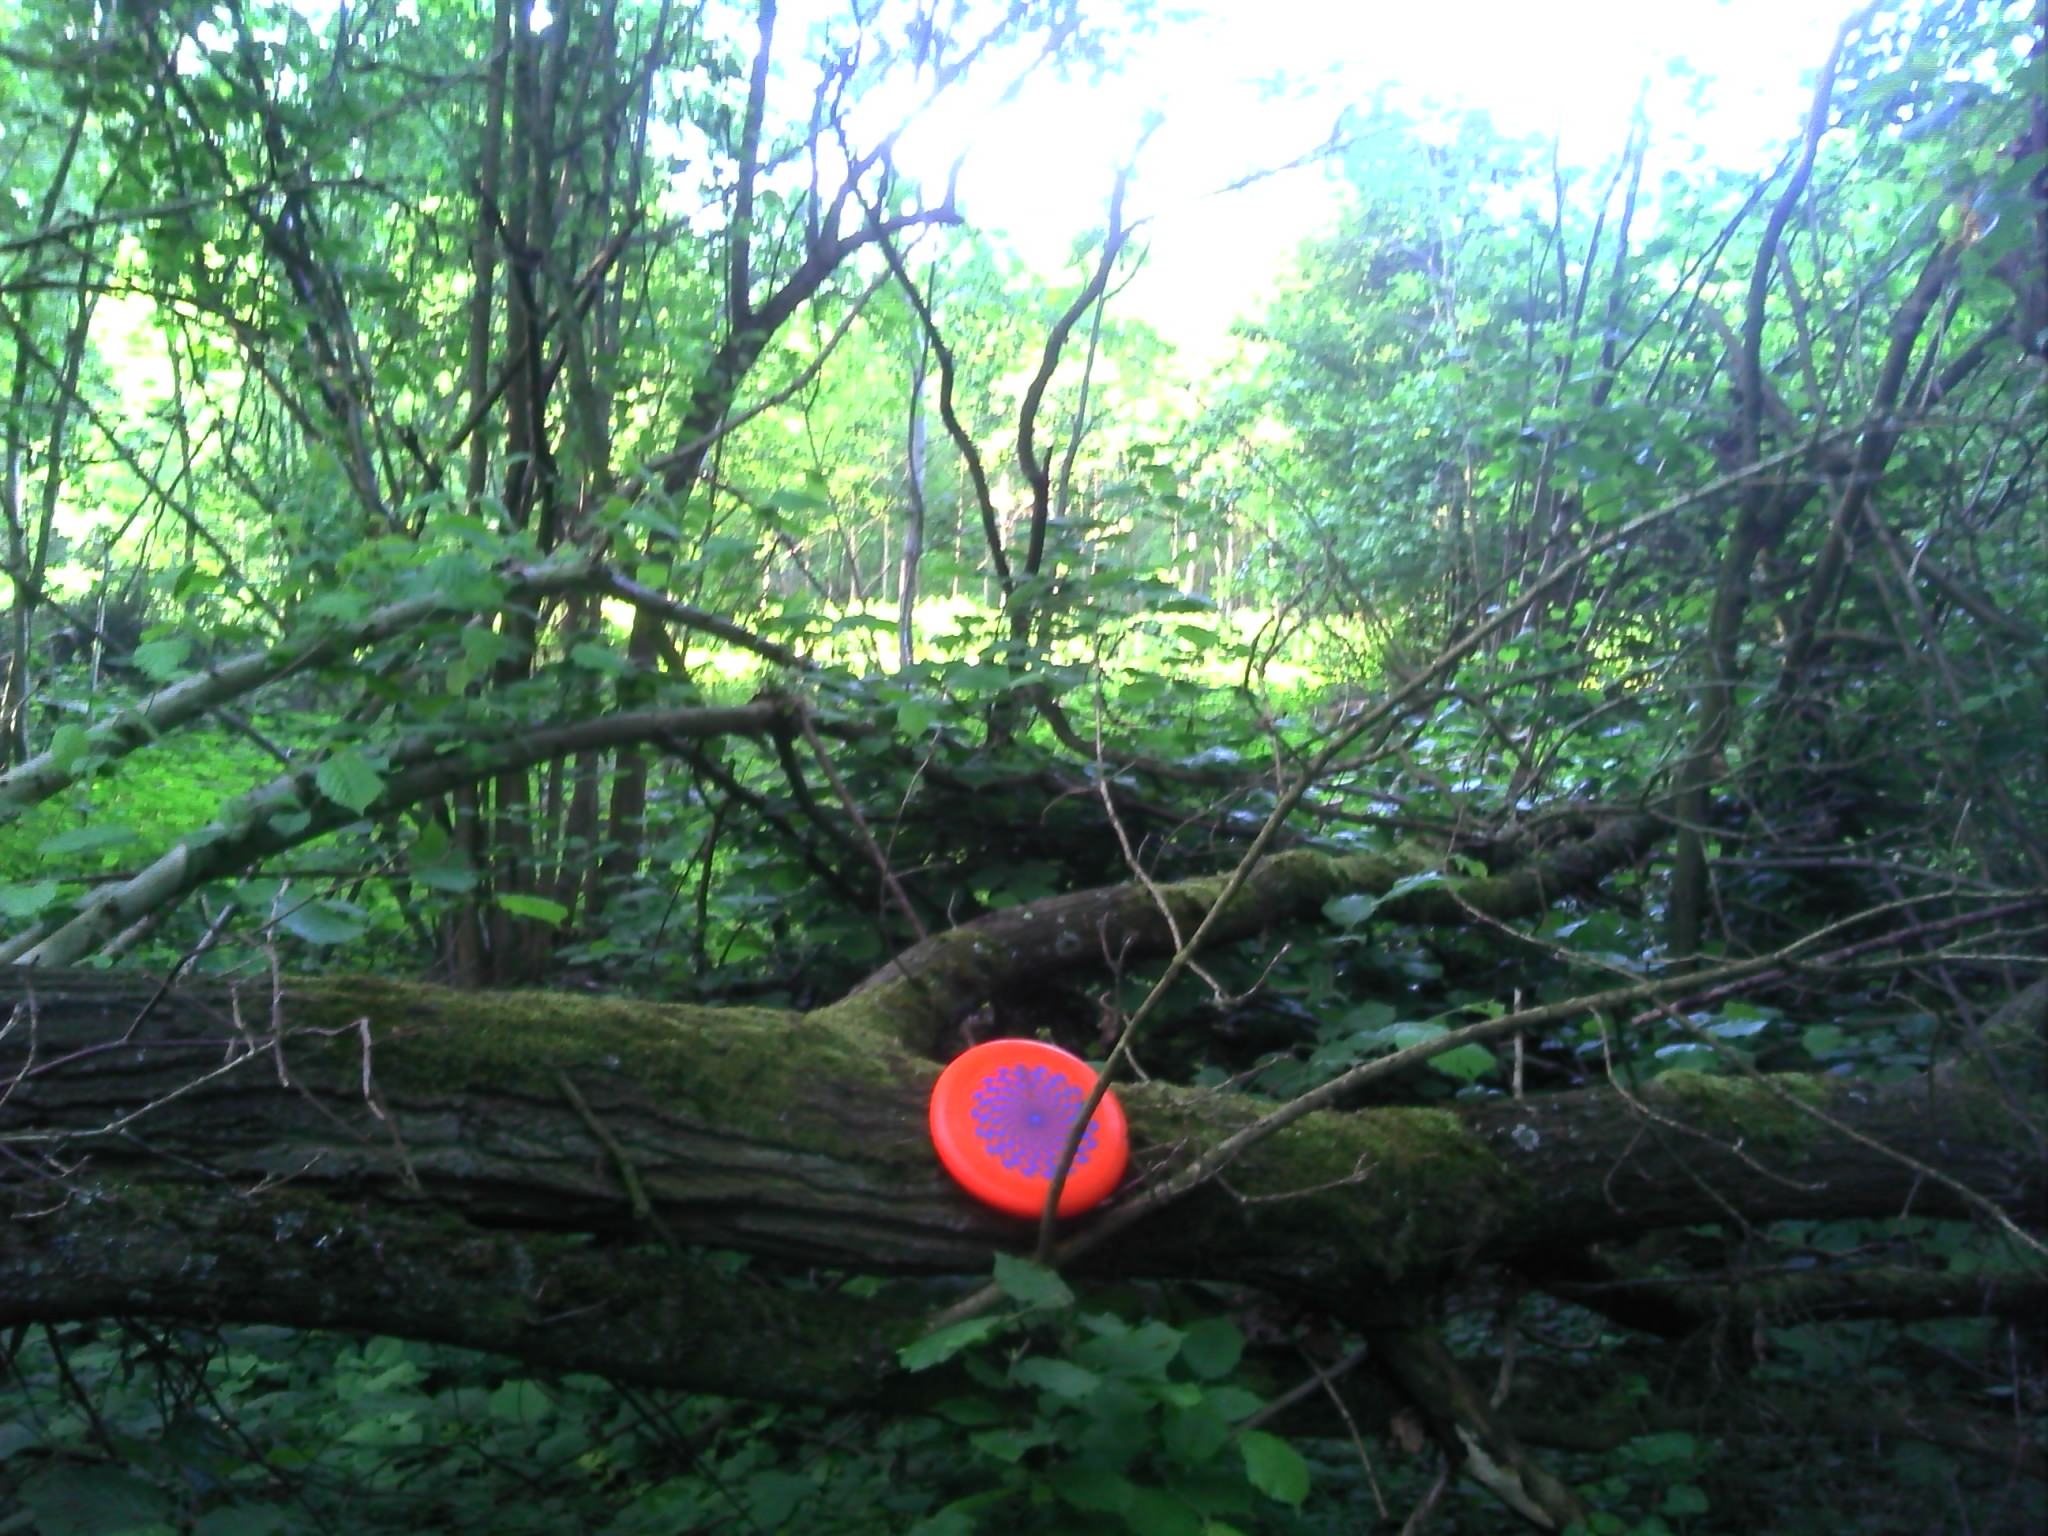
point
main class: Woodland
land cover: Broadleaved woodland
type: mesophytic deciduous forest
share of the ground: > 75 %
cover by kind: broadleaved forest trees 85 %, herbaceous plants 15 %
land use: Forestry
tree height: > 5 m
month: June
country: BE
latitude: 50.5875
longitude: 4.7847
